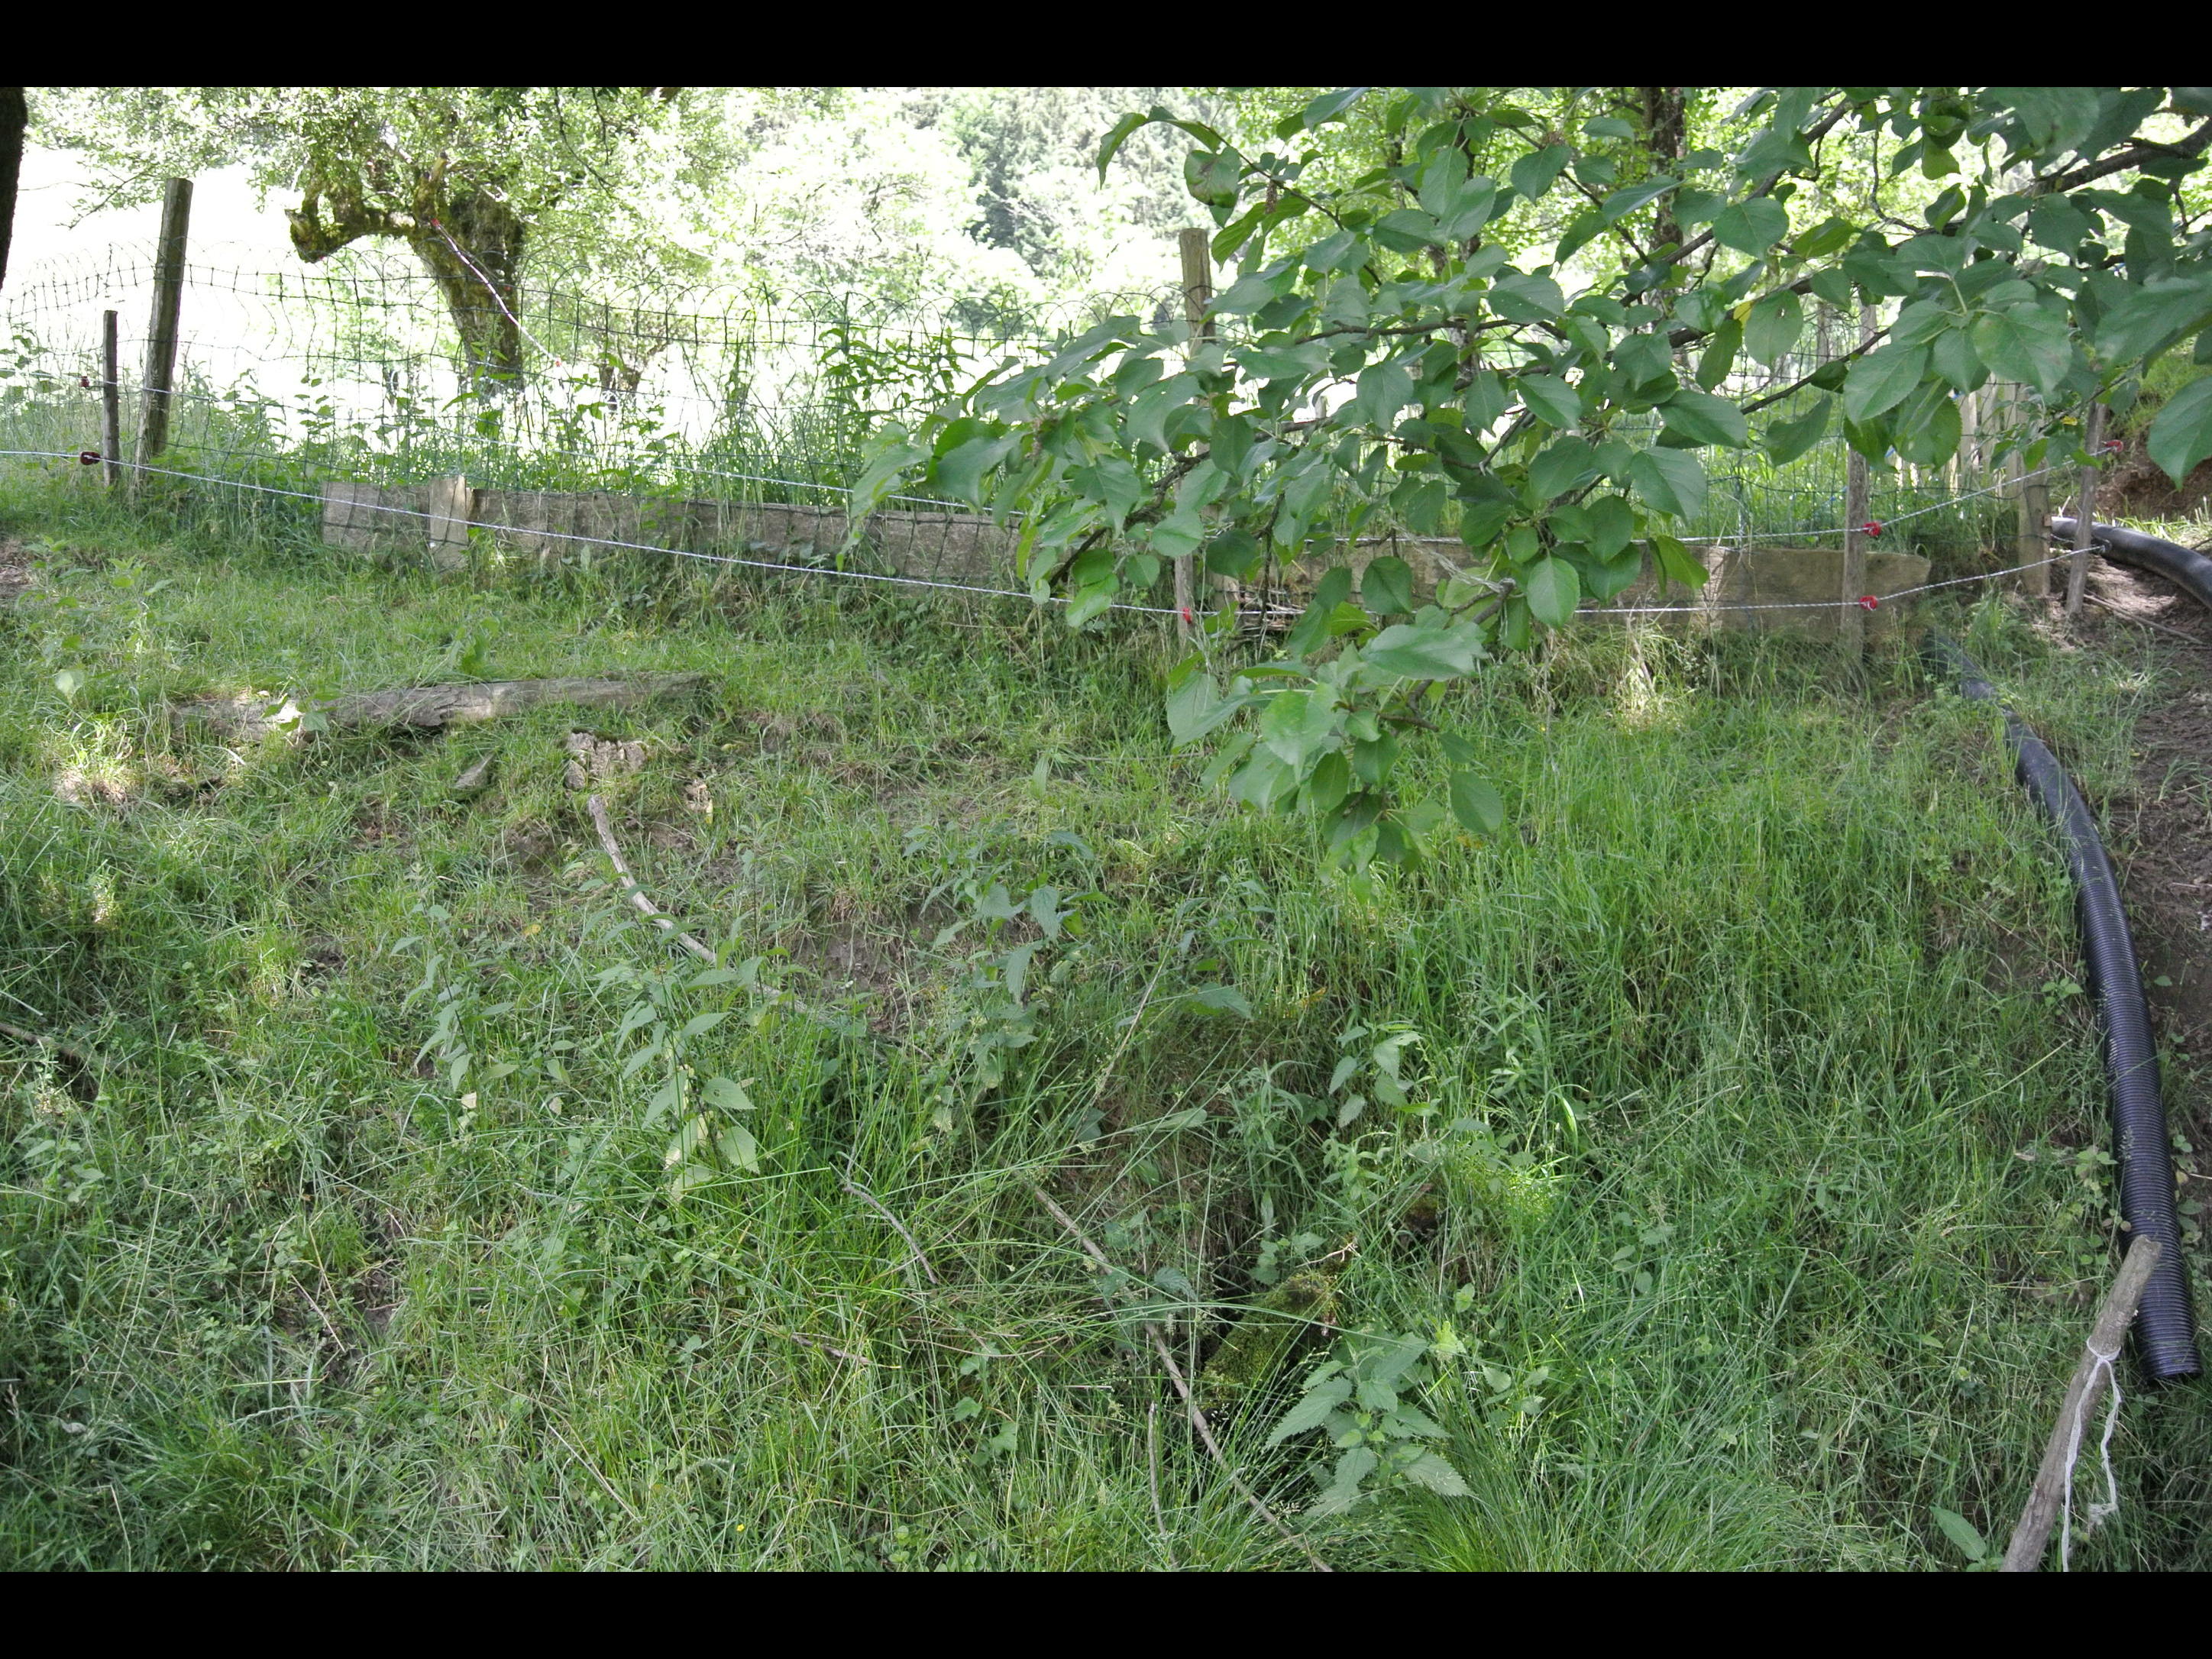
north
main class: Cropland
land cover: Nuts trees
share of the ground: > 75 %
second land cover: Grassland without tree/shrub cover
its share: > 75 %
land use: Agriculture (excluding fallow land and kitchen gardens)
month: June
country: AT
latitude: 47.9484
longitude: 15.3706
